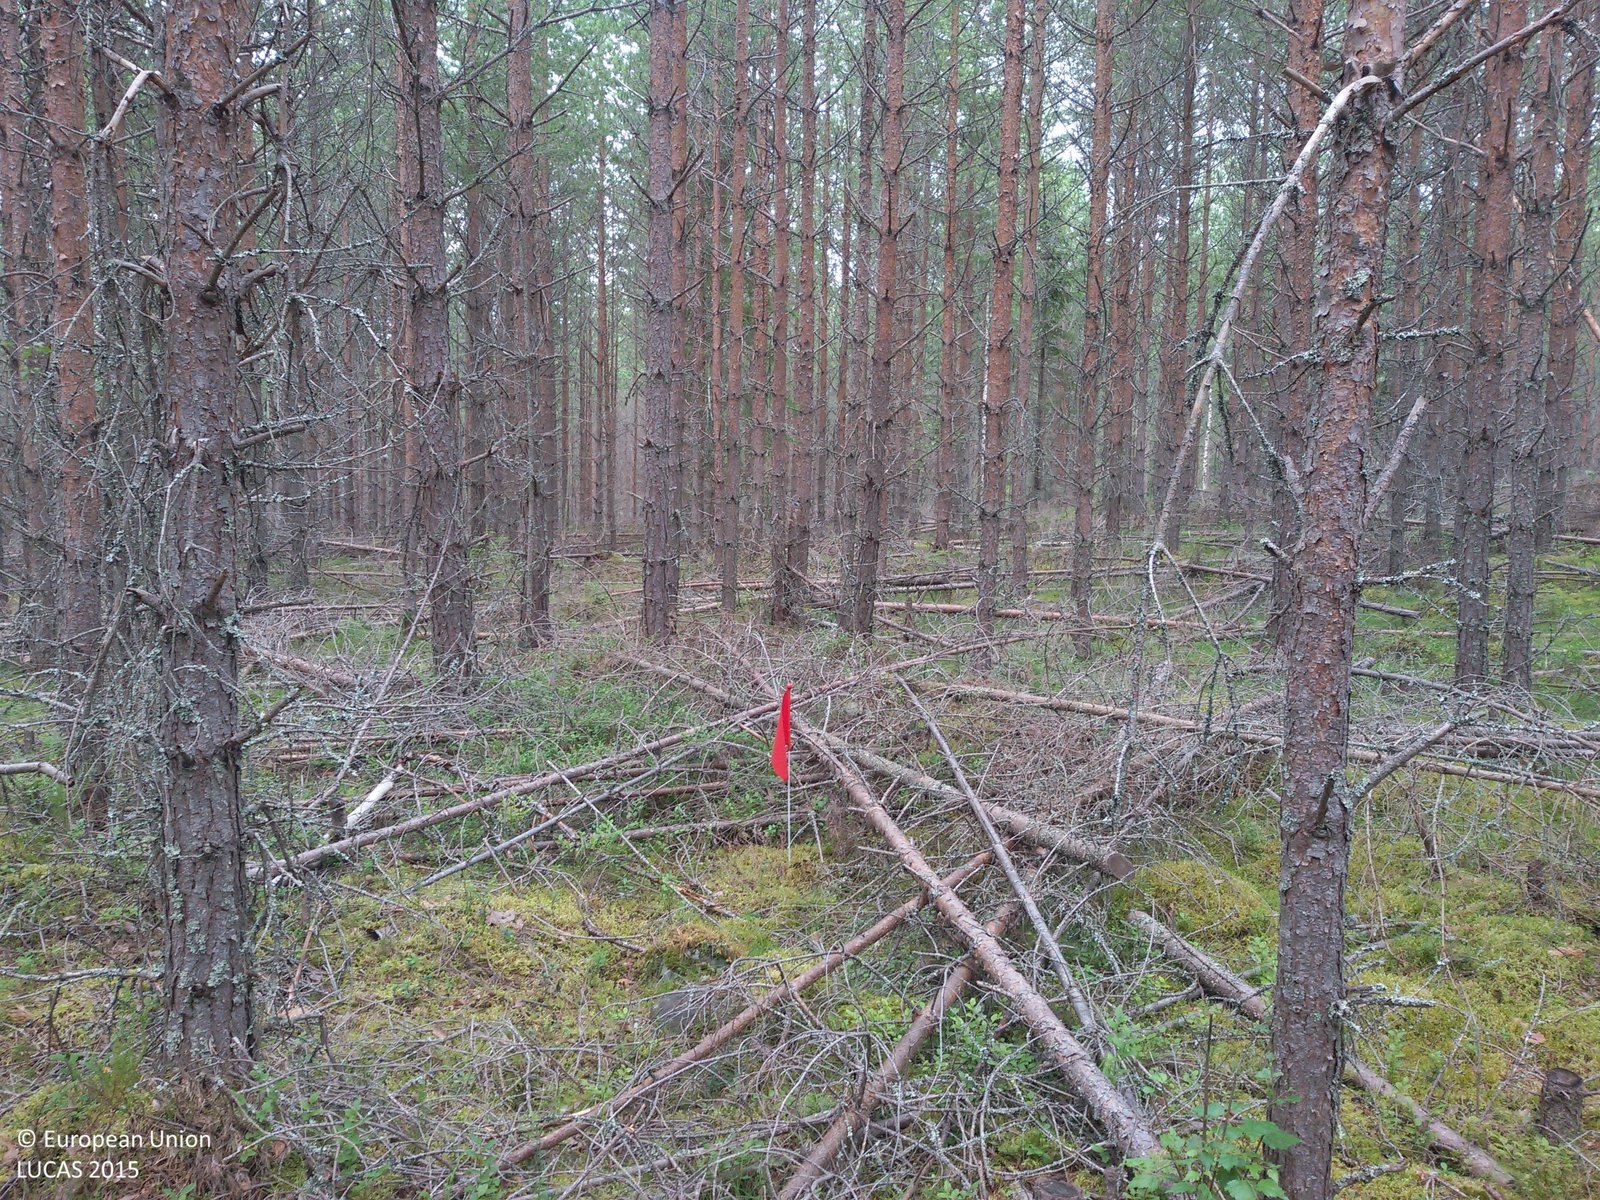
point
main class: Woodland
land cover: Pine dominated coniferous woodland
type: boreal forest
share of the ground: > 75 %
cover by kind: coniferous forest trees 80 %, shrubs 20 %
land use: Forestry
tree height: > 5 m
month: July
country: SE
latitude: 60.5085
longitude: 15.9062
